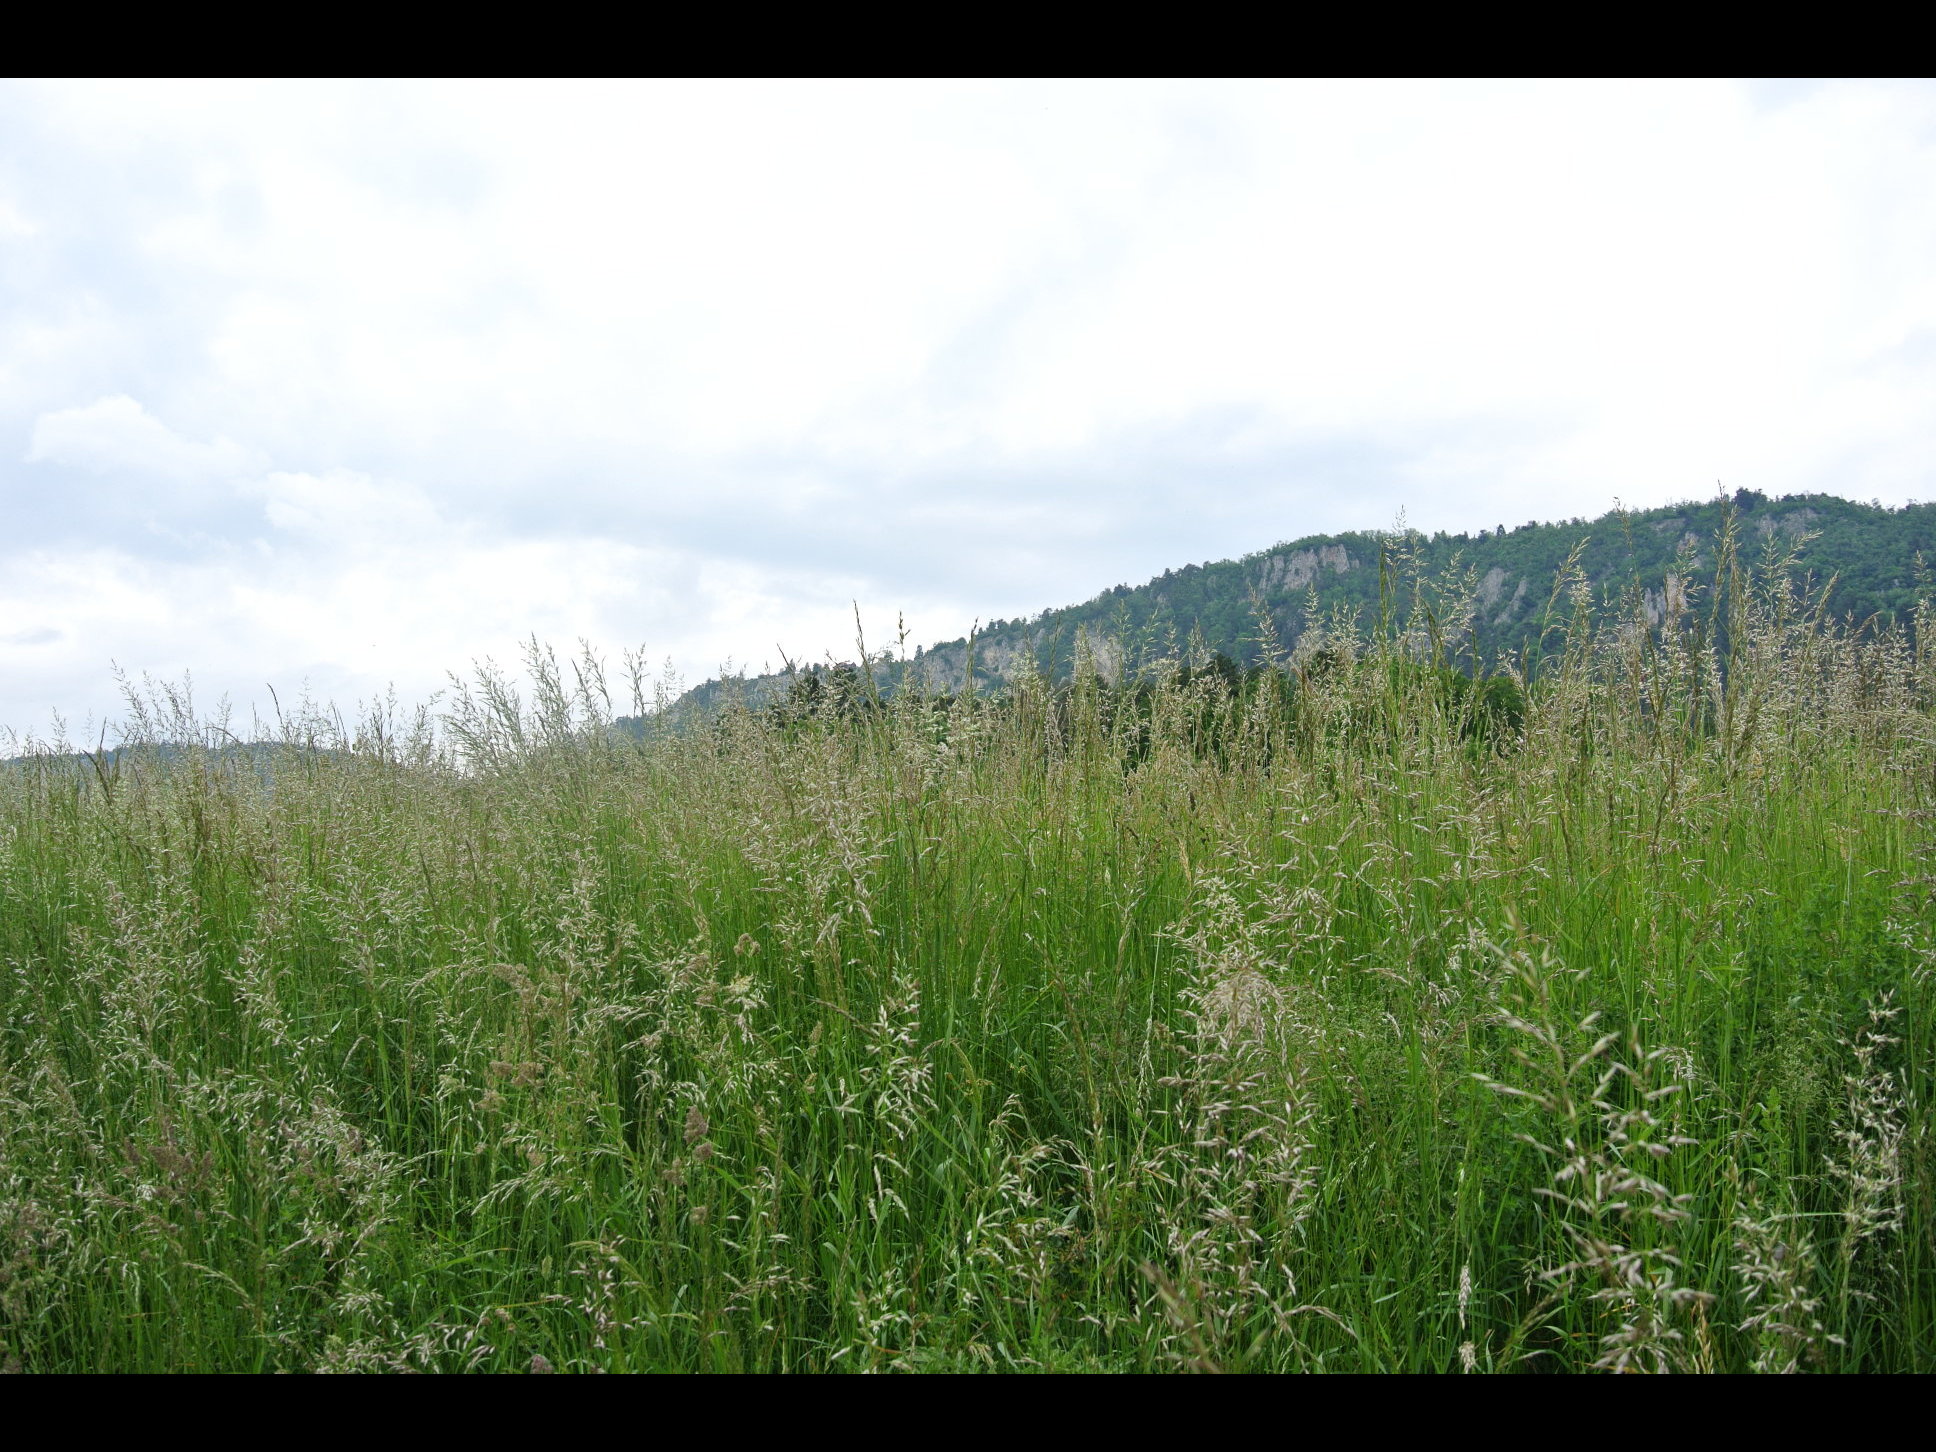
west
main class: Grassland
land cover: Grassland without tree/shrub cover
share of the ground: > 75 %
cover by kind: herbaceous plants 100 %
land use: Agriculture (excluding fallow land and kitchen gardens)
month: May
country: AT
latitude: 47.8390
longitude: 16.0826
